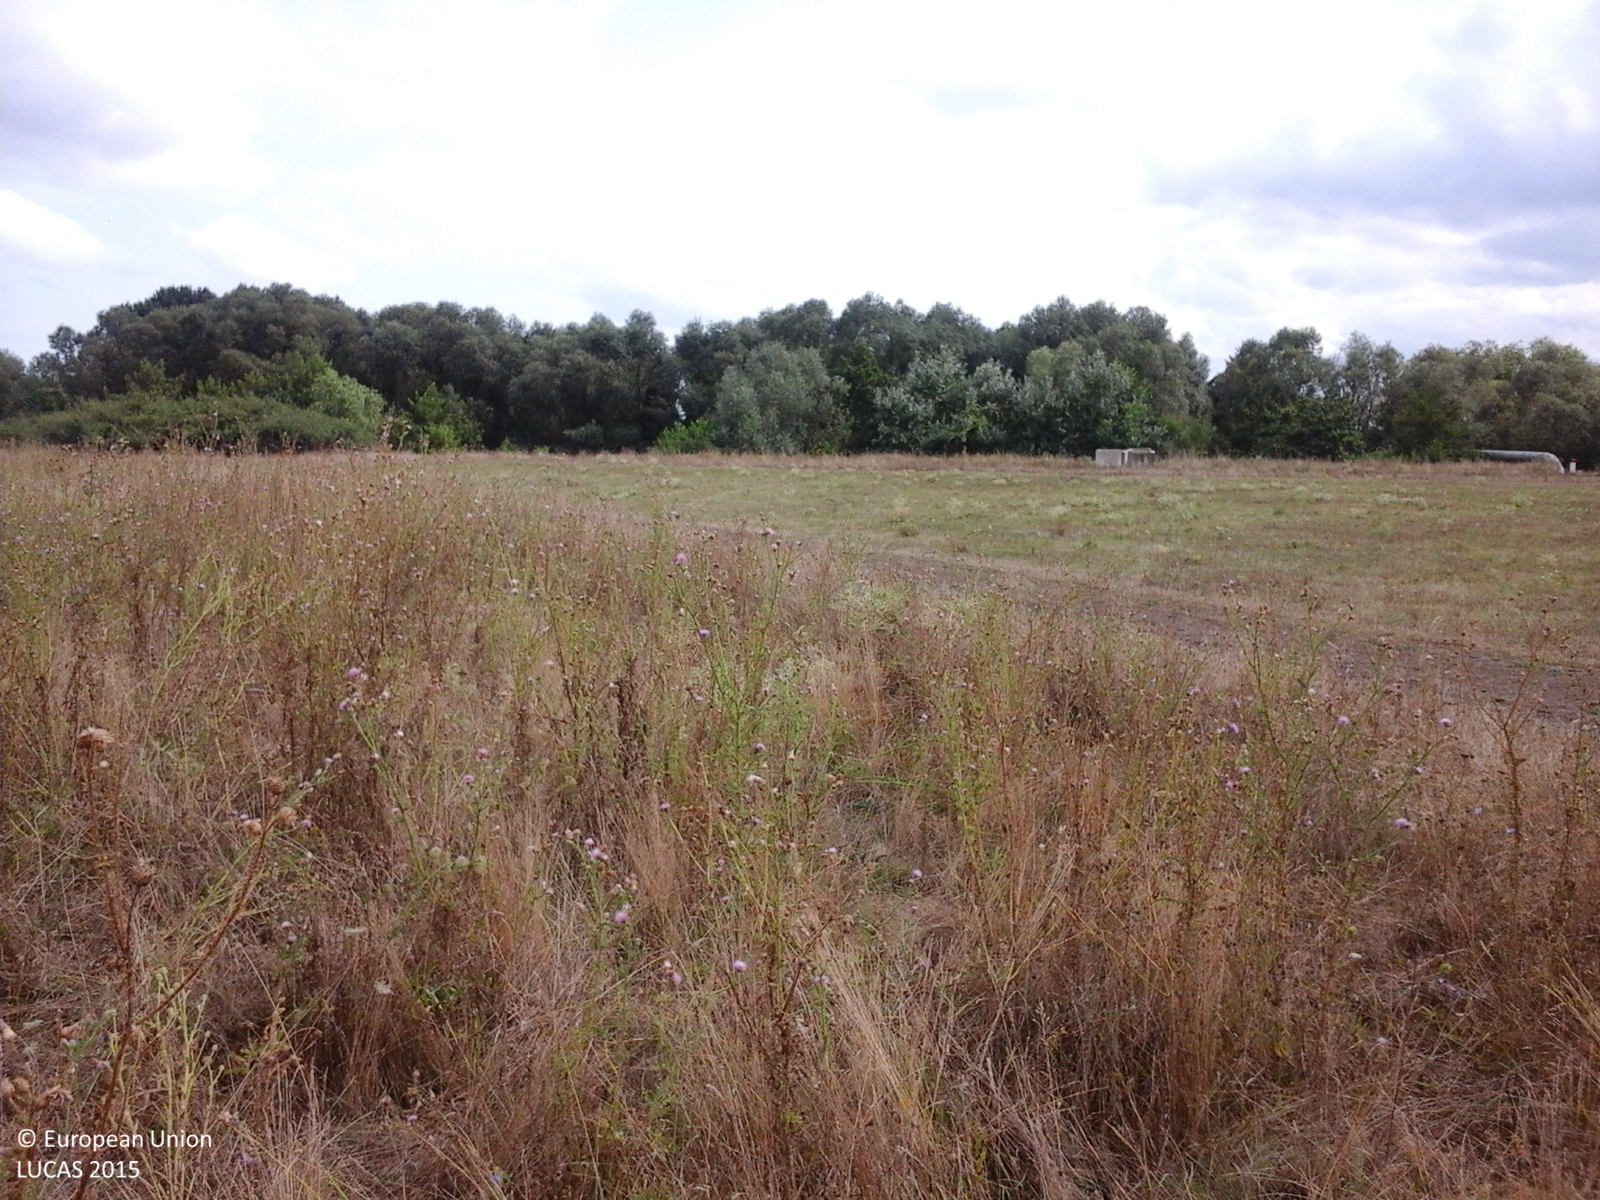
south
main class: Grassland
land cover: Spontaneously vegetated surfaces
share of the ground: > 75 %
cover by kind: herbaceous plants 100 %
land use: Fallow land
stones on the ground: < 10 %
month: August
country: RO
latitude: 45.7772
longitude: 21.3887
